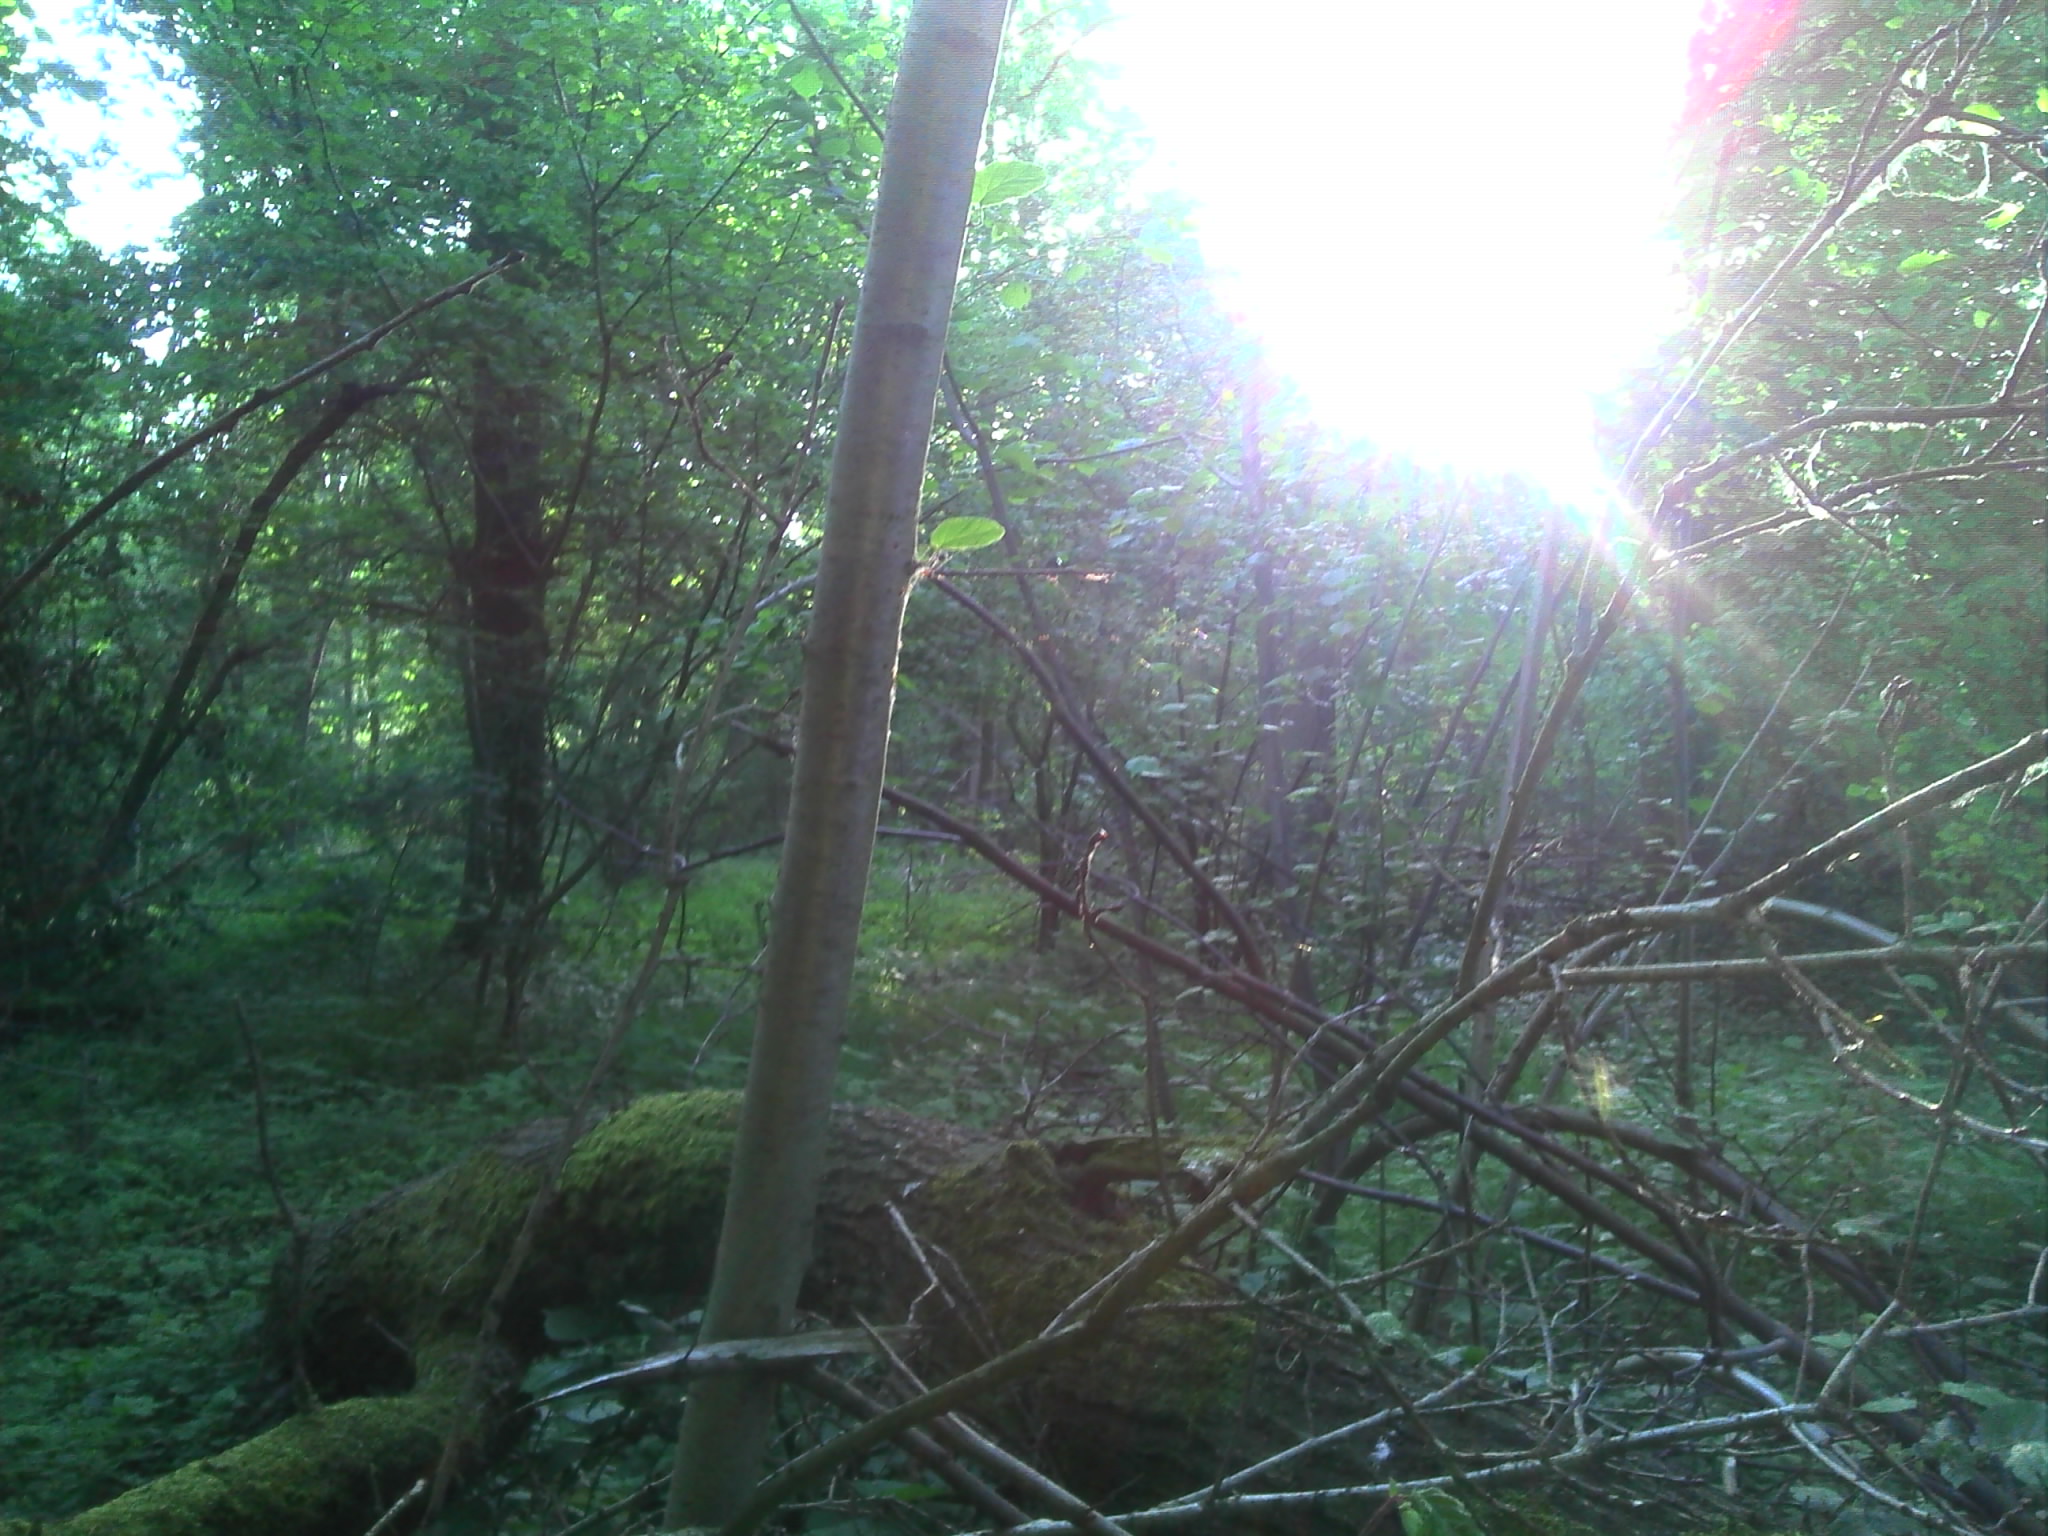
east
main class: Woodland
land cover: Broadleaved woodland
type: mesophytic deciduous forest
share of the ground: > 75 %
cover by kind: broadleaved forest trees 85 %, herbaceous plants 15 %
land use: Forestry
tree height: > 5 m
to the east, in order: Broadleaved woodland; Grass margins; Paved roads, cycling and walking lanes; Grass margins; Broadleaved woodland; Tracks; Broadleaved woodland
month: June
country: BE
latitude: 50.5875
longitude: 4.7847
